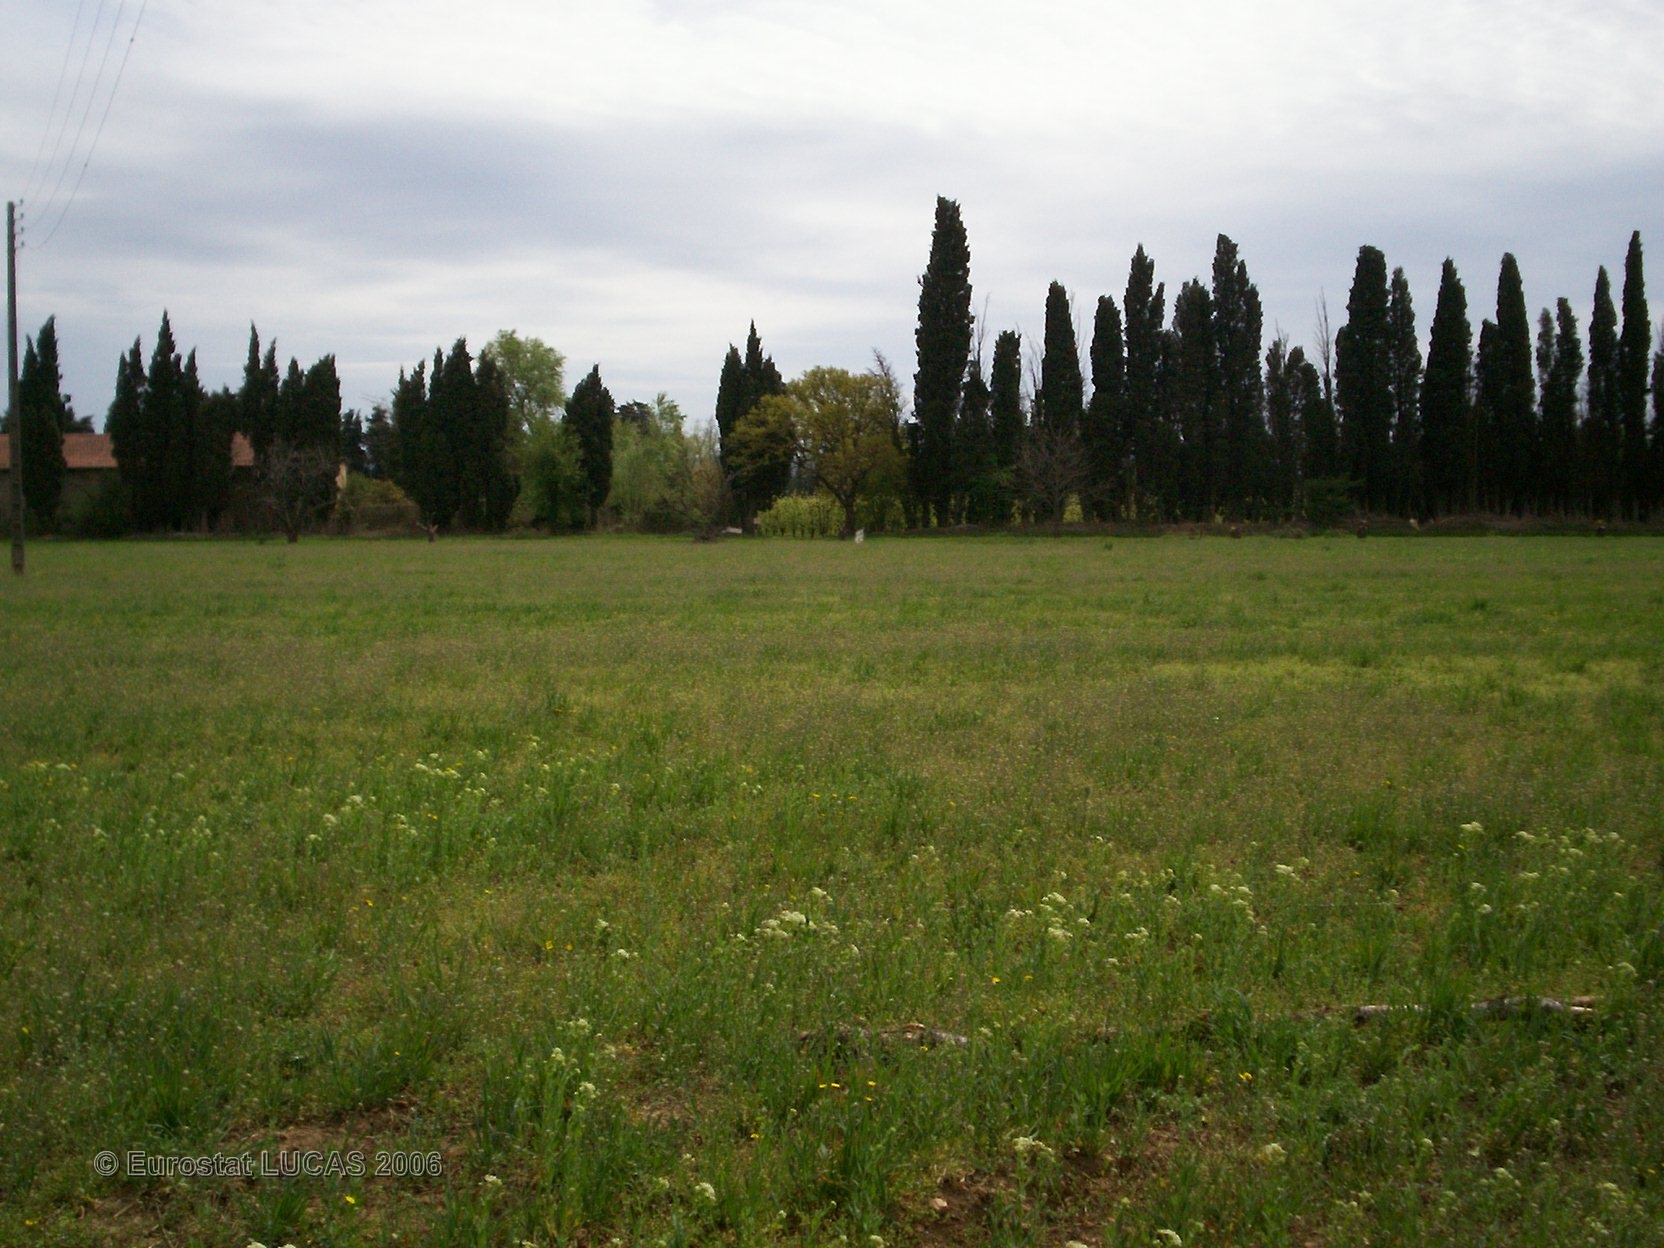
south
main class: Cropland
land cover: Oats
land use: Agriculture (excluding fallow land and kitchen gardens)
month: April
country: FR
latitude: 43.8132
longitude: 4.9741
